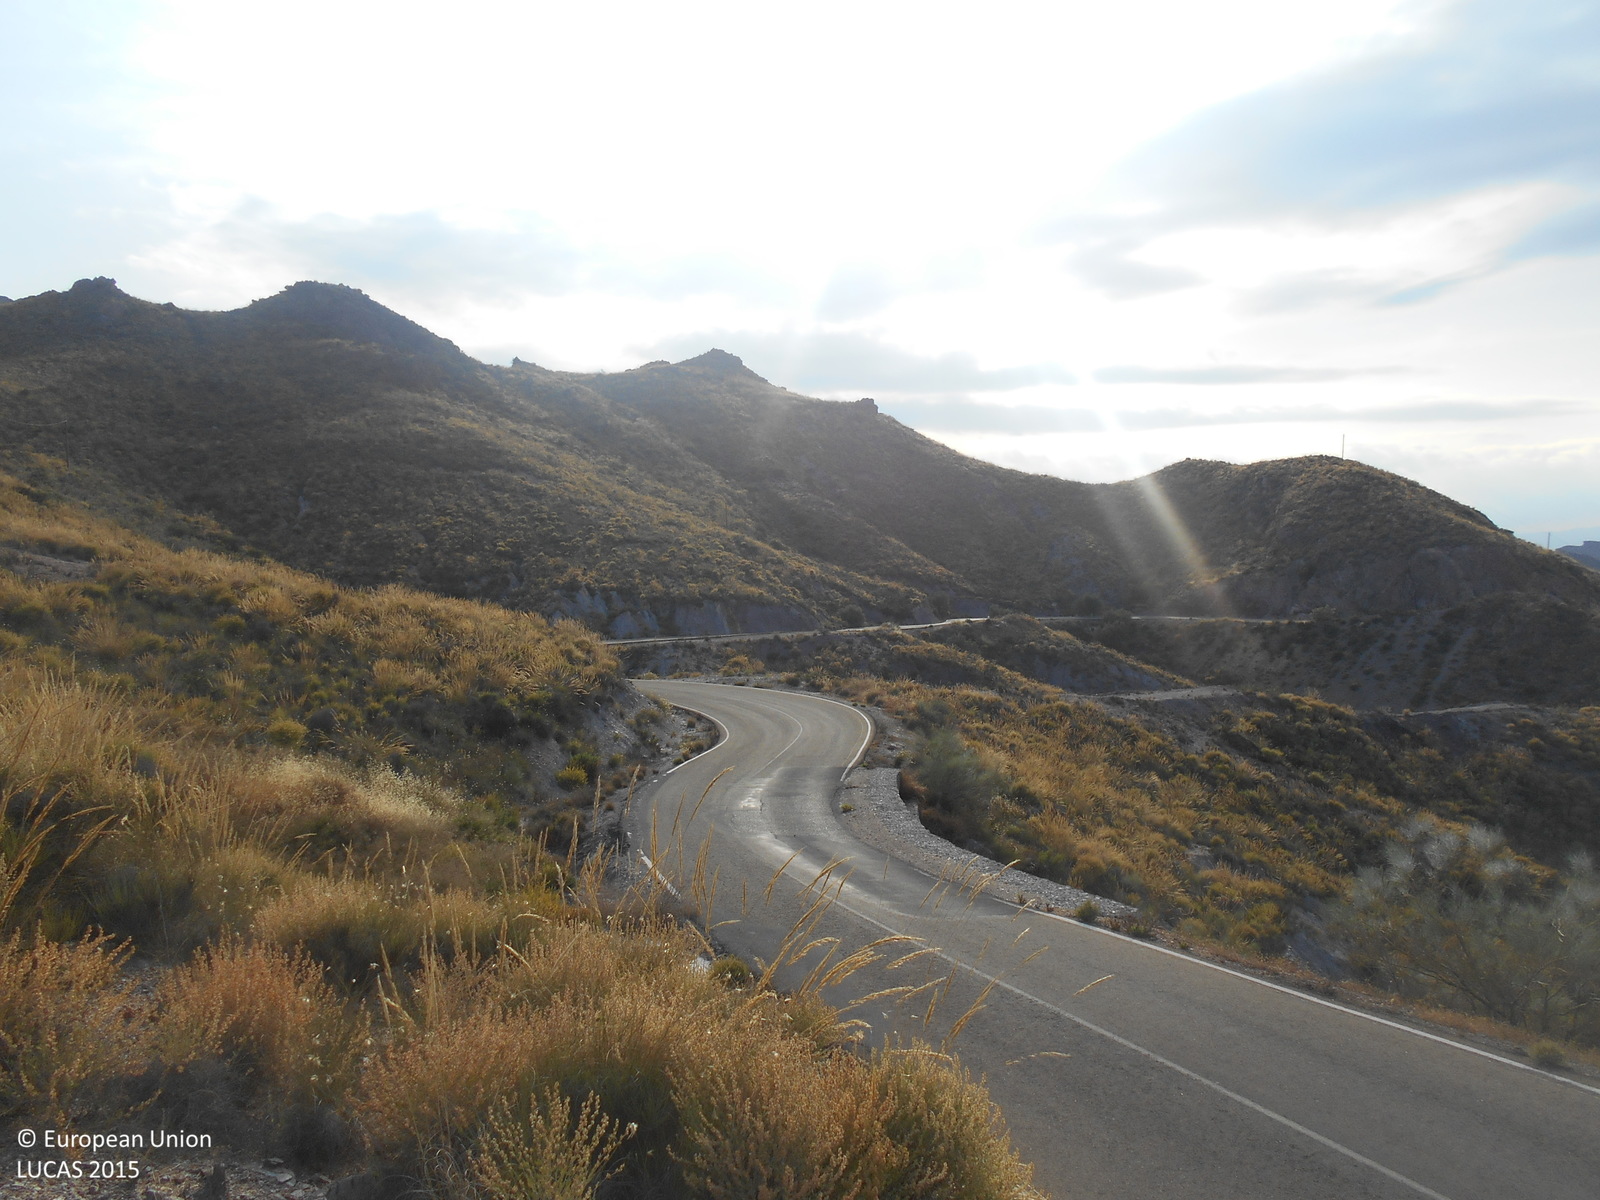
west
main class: Shrubland
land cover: Shrubland without tree cover
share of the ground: 10 - 25 %
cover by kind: unconsolidated bare surface 60 %, shrubs 20 %, herbaceous plants 10 %, consolidated bare surface 10 %
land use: Semi-natural and natural areas not in use
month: May
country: ES
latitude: 37.0355
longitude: -2.1742
